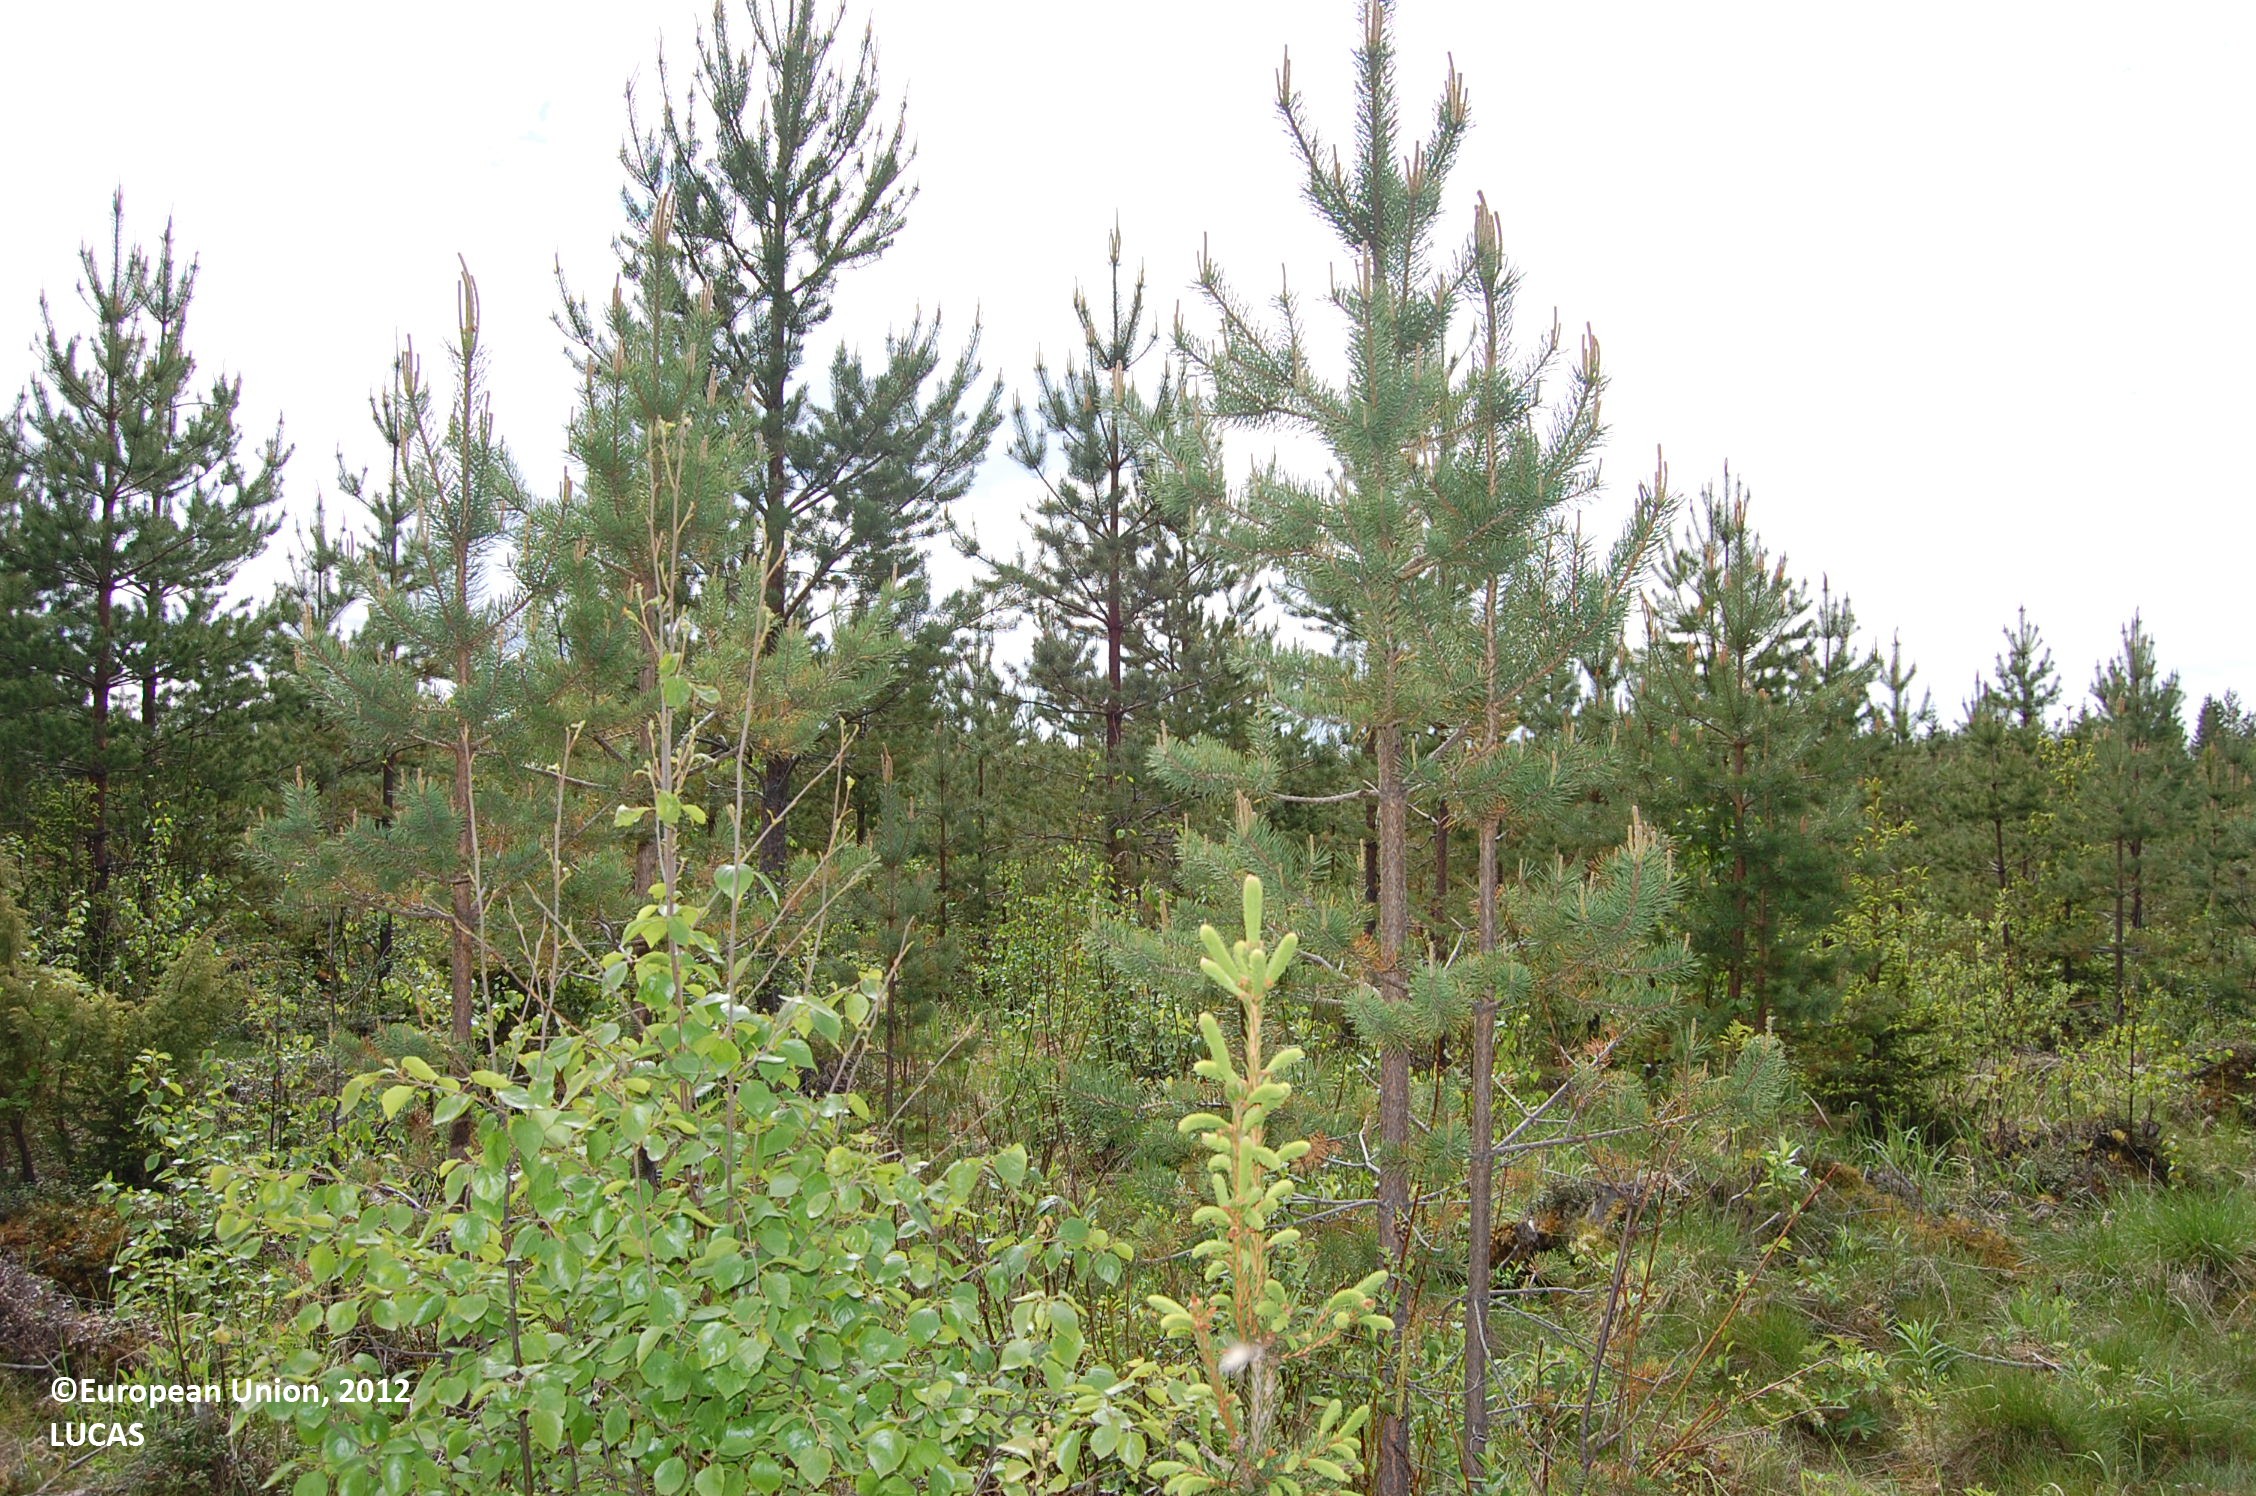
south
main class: Woodland
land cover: Pine dominated coniferous woodland
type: hemiboreal forest and nemoral coniferous forest and mixed broadleaved-coniferous forest
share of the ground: 25 - 50 %
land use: Forestry
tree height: < 5 m
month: June
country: FI
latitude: 63.9787
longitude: 26.0658
